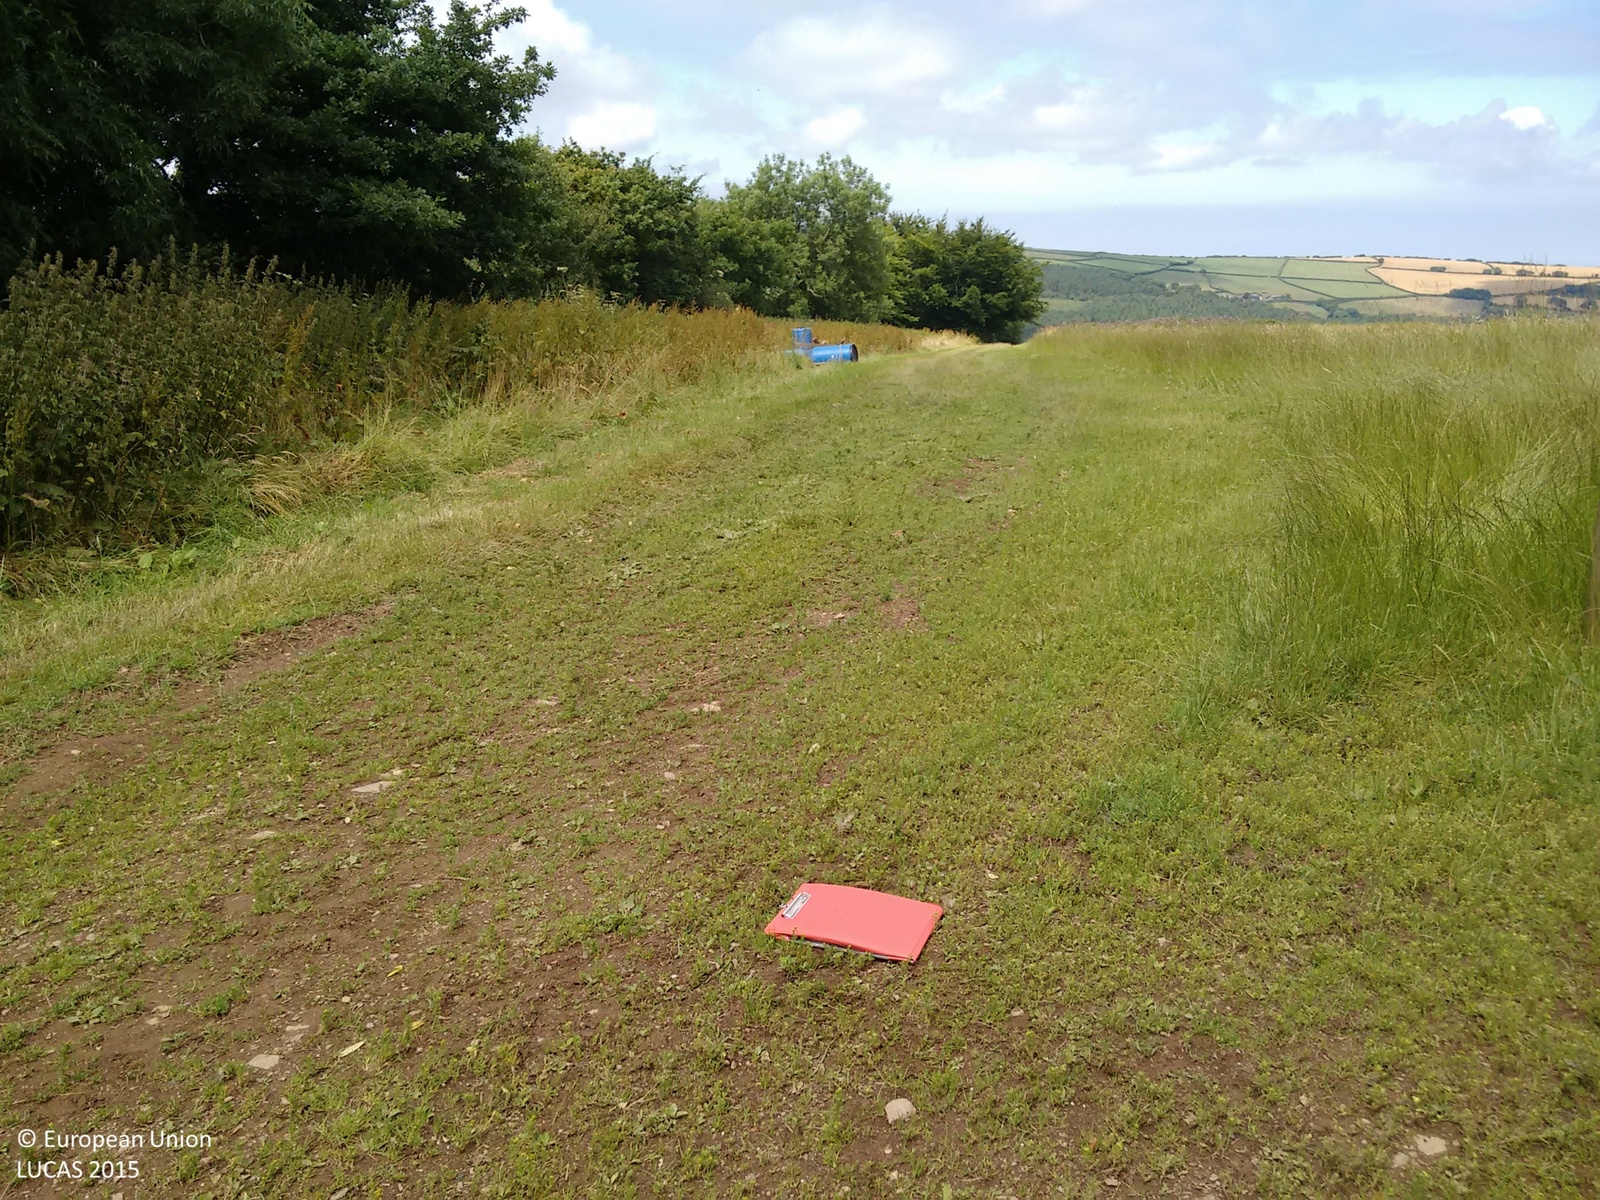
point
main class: Grassland
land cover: Spontaneously vegetated surfaces
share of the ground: > 75 %
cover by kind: herbaceous plants 75 %, unconsolidated bare surface 25 %
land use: Agriculture (excluding fallow land and kitchen gardens)
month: July
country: GB
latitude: 51.1162
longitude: -3.4401
